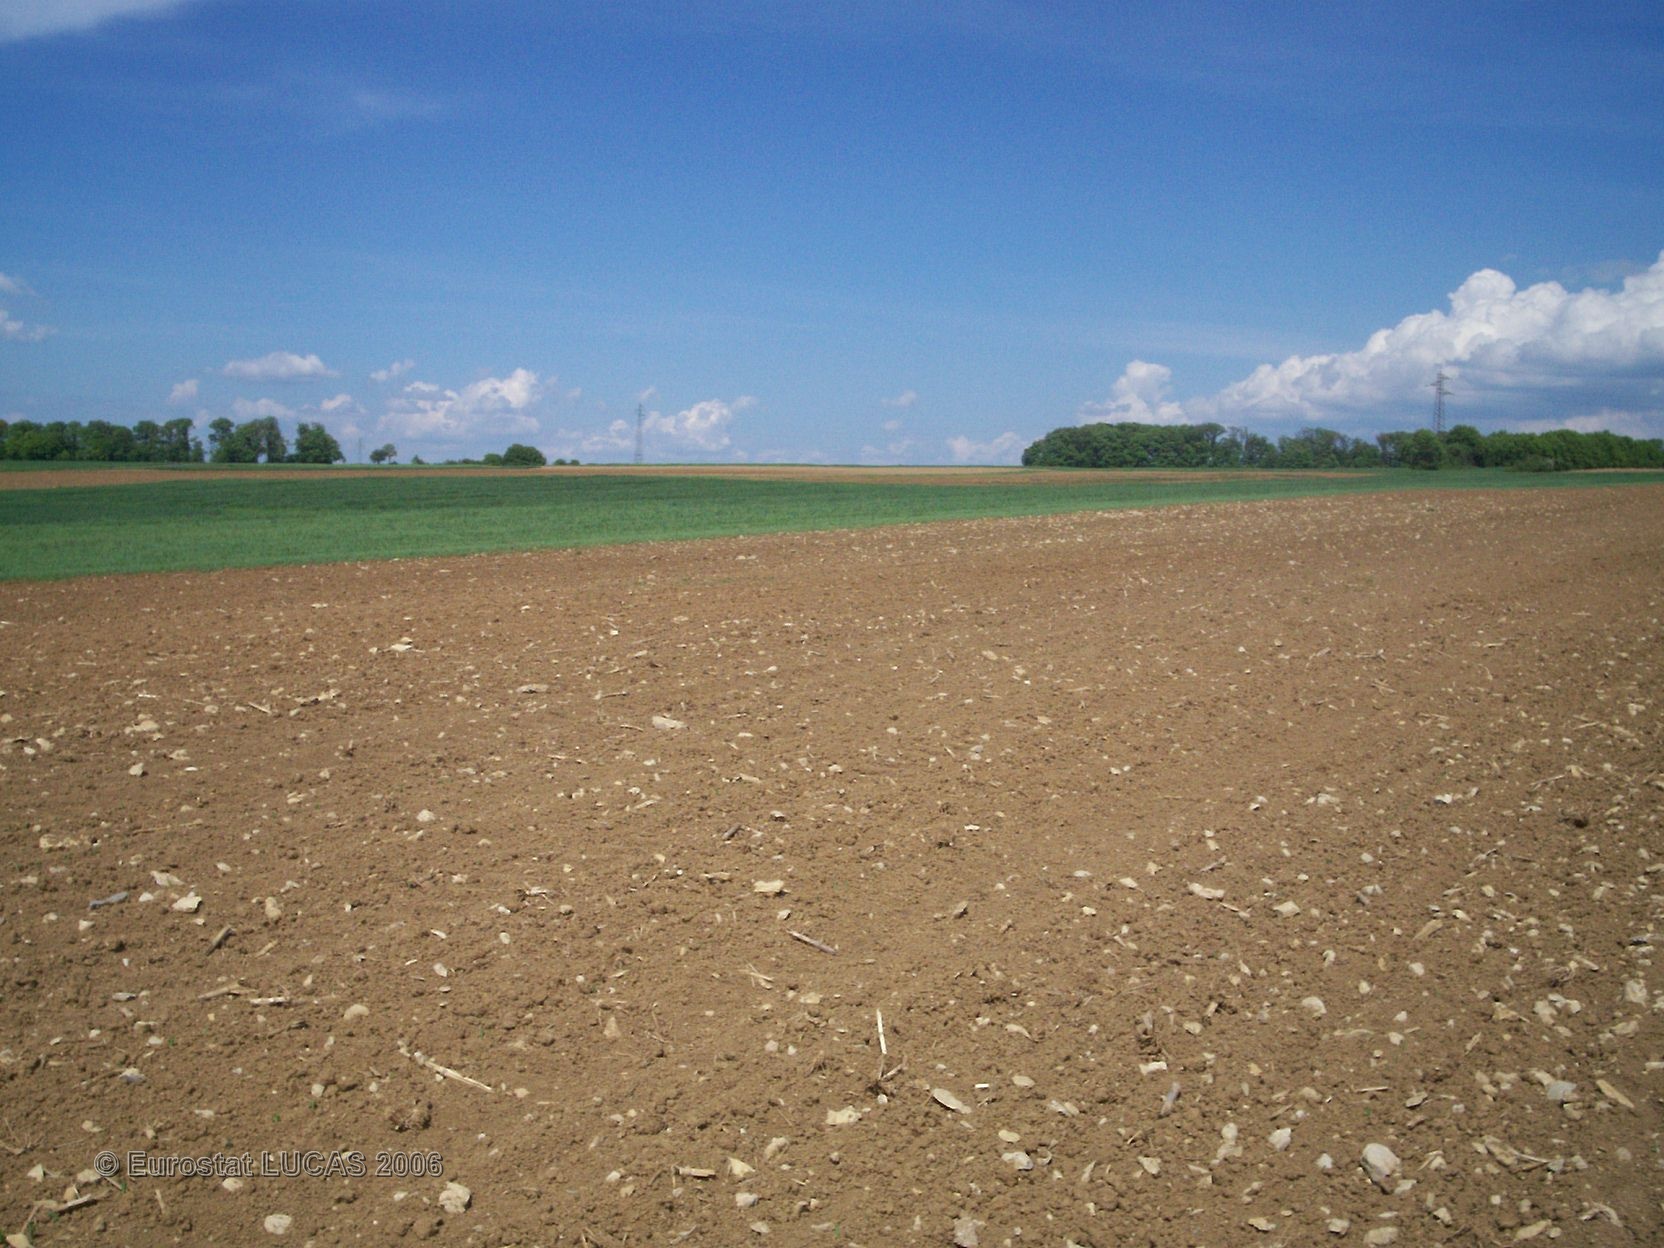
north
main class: Cropland
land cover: Maize
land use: Agriculture (excluding fallow land and kitchen gardens)
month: May
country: FR
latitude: 48.7789
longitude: 7.0747
